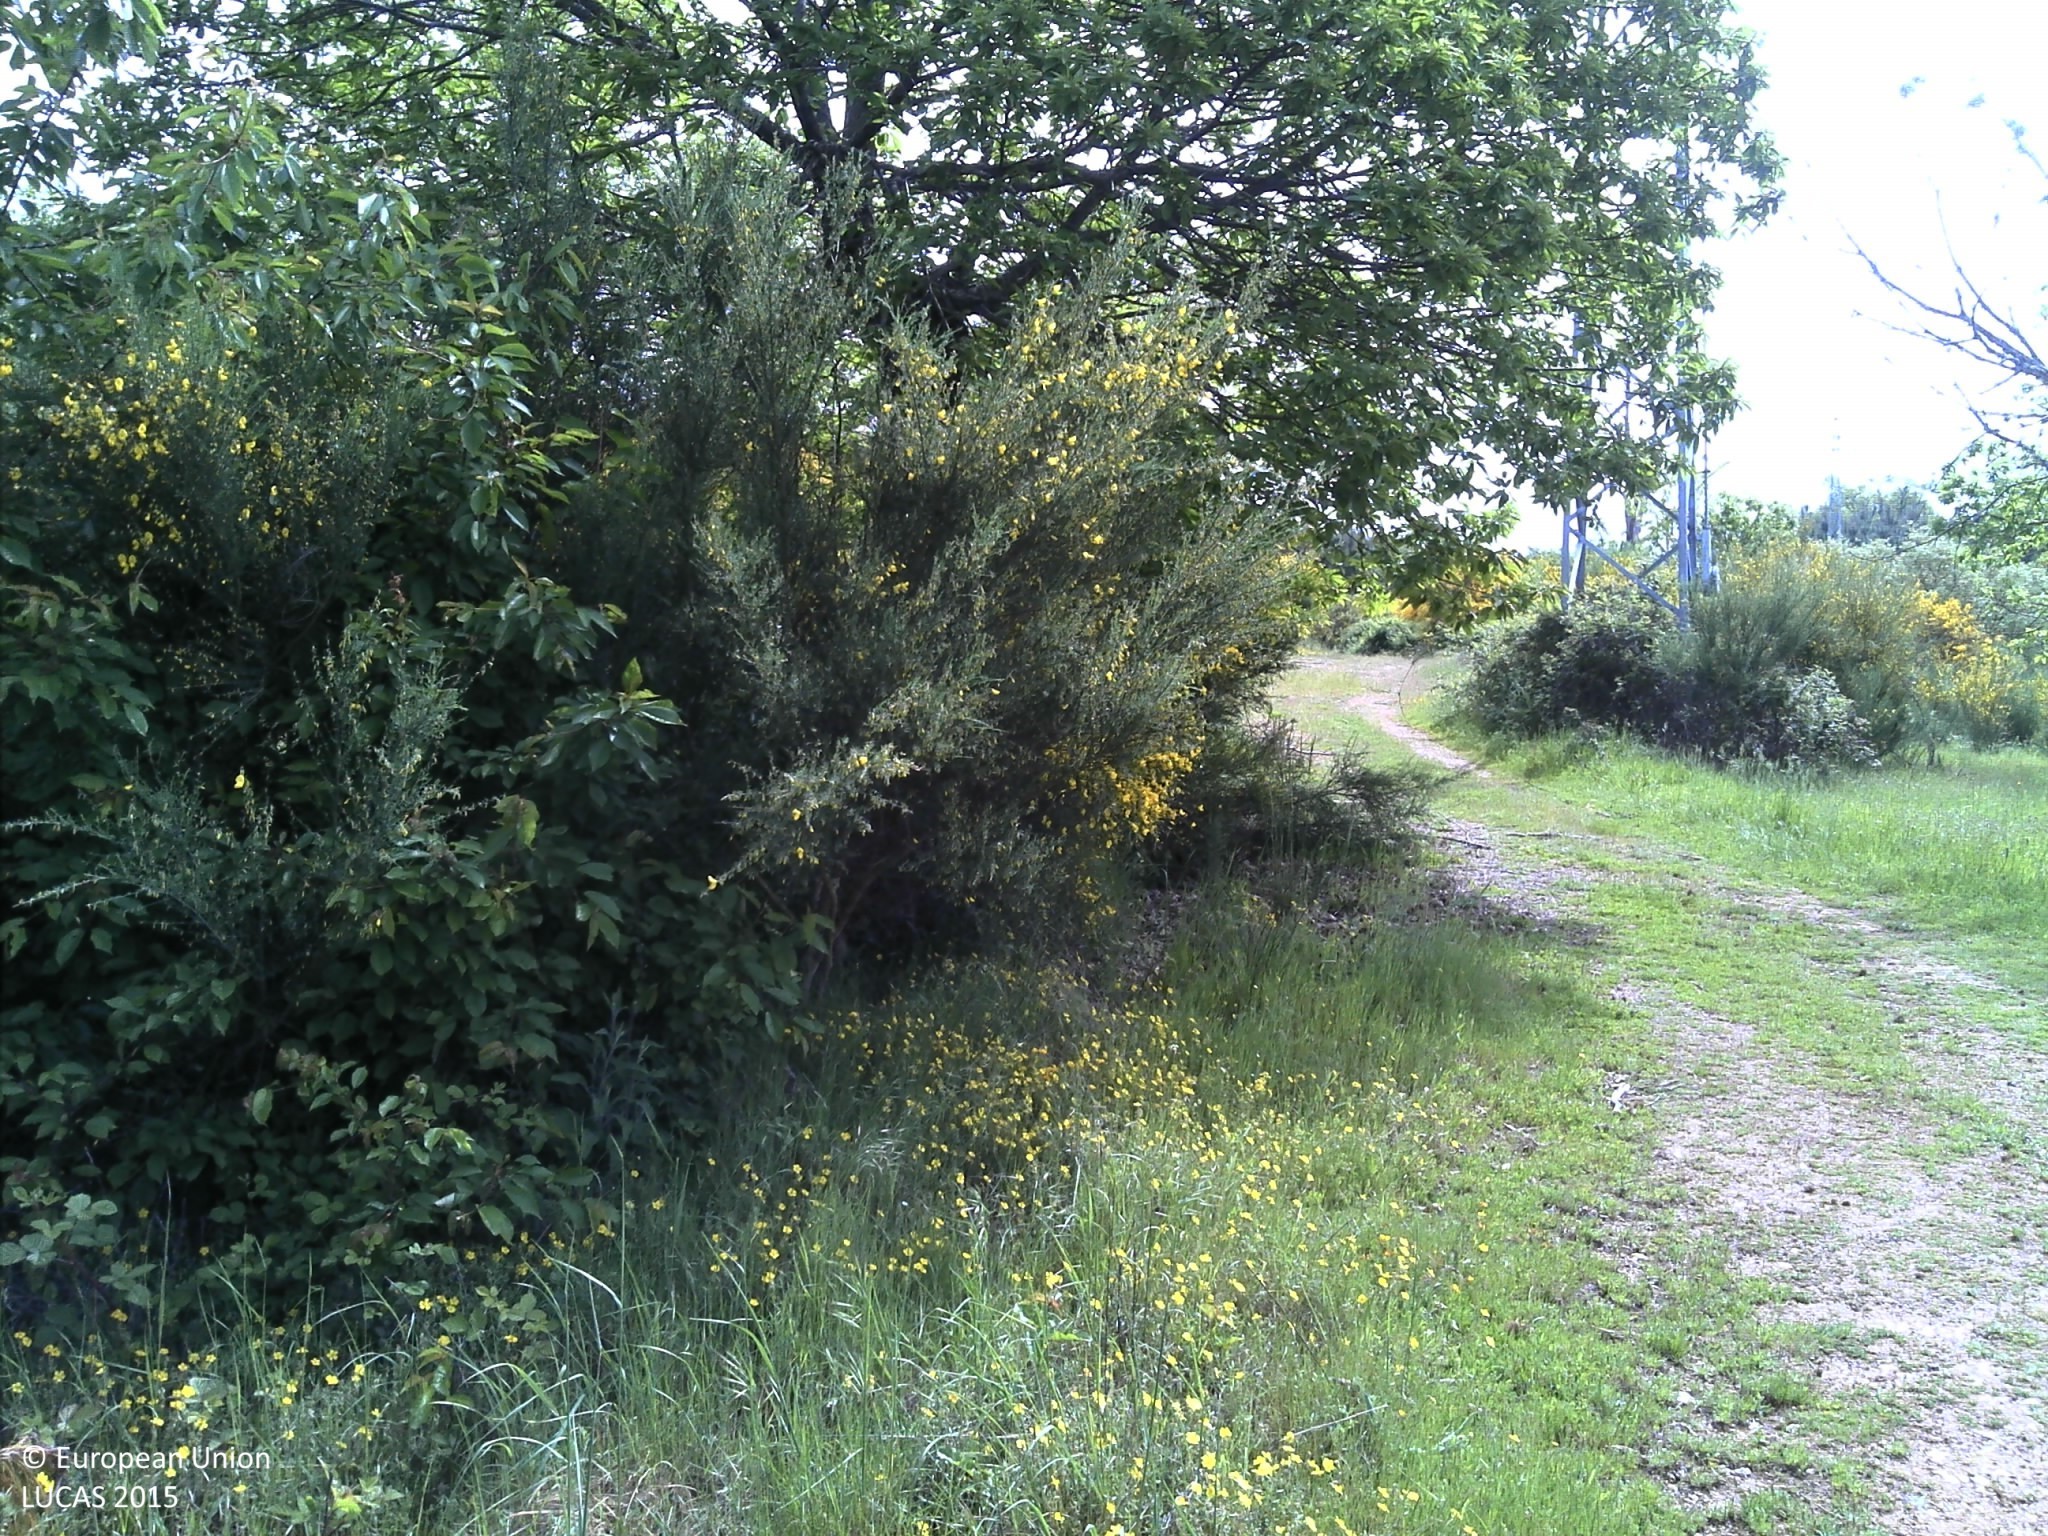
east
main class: Woodland
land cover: Pine dominated coniferous woodland
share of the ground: 25 - 50 %
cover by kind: coniferous forest trees 45 %, shrubs 30 %, herbaceous plants 25 %
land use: Forestry
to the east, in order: Pine dominated coniferous woodland; Grass margins; Electric lines; Shrubland with sparse tree cover; Spontaneously vegetated surfaces; Shrubland with sparse tree cover; Spontaneously vegetated surfaces; Shrubland with sparse tree cover; Pine dominated coniferous woodland; Shrubland with sparse tree cover; Other bare soil
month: May
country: PT
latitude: 41.8959
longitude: -7.1555
